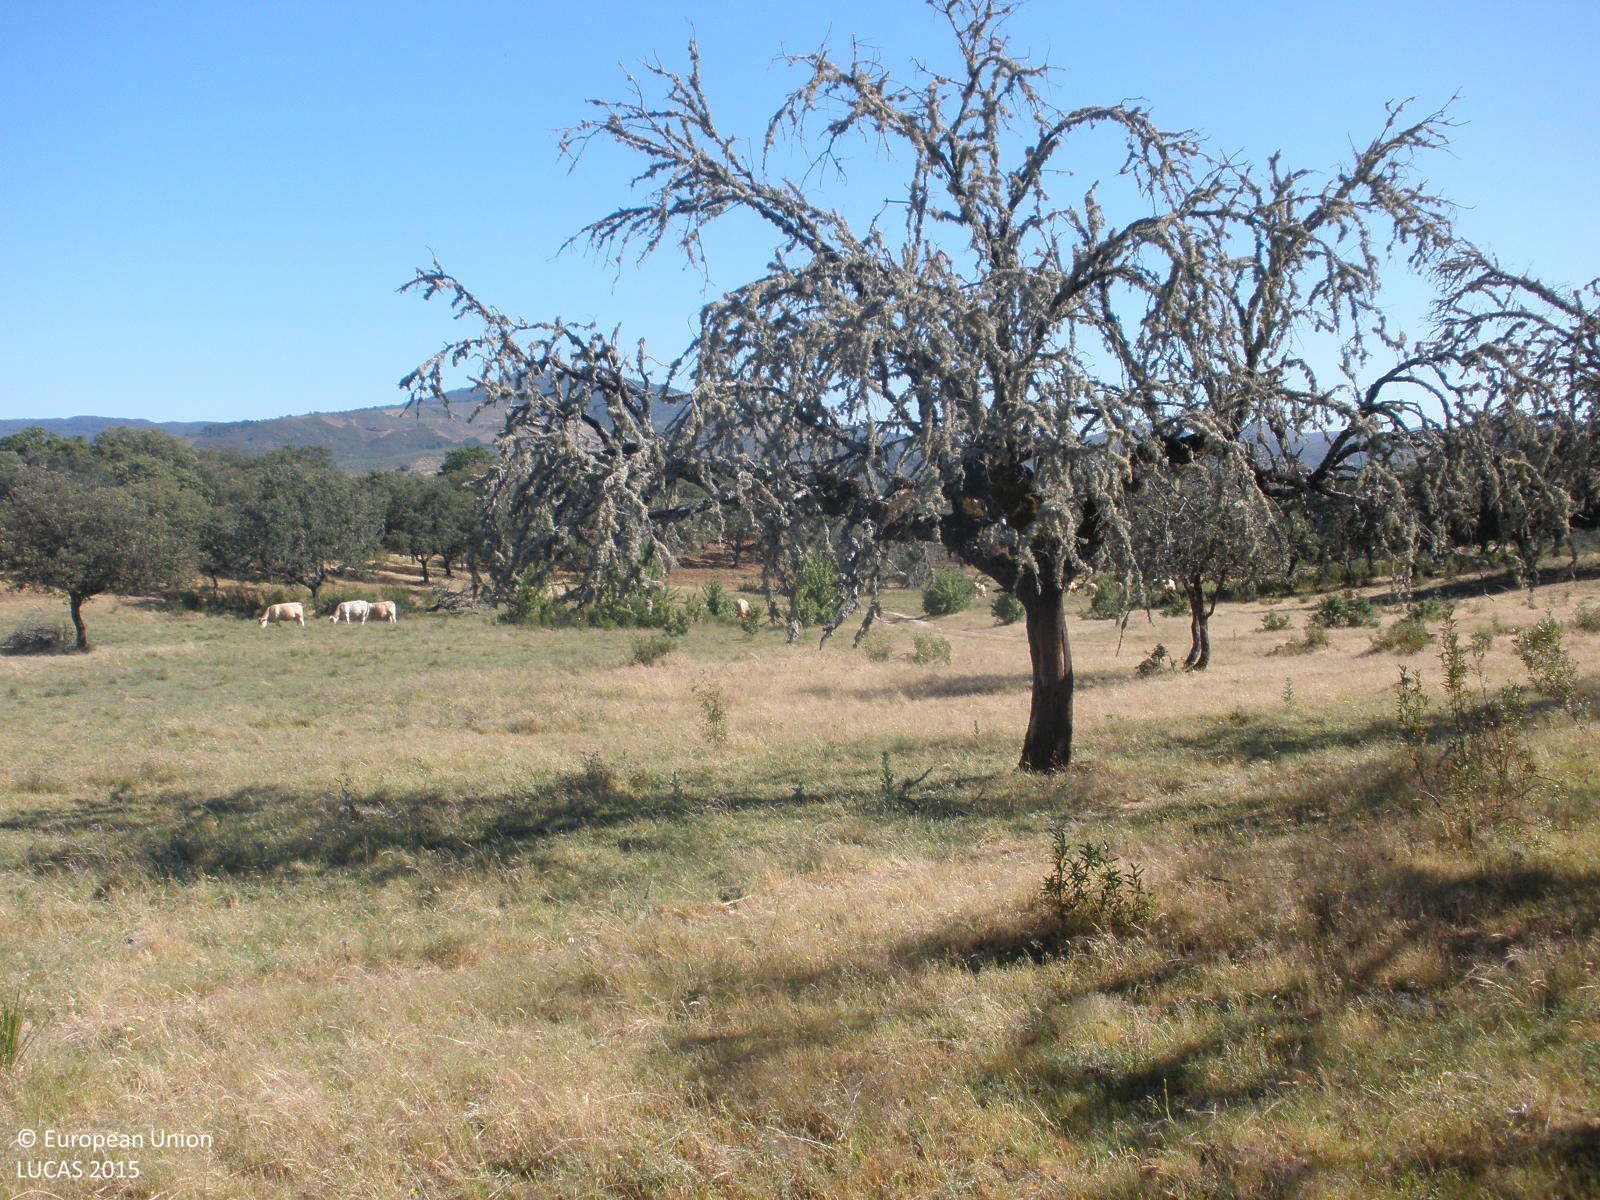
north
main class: Woodland
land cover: Broadleaved woodland
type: broadleaved evergreen forest
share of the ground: 50 - 75 %
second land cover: Grassland without tree/shrub cover
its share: > 75 %
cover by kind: herbaceous plants 60 %, broadleaved forest trees 35 %, shrubs 5 %
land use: Forestry
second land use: Agriculture (excluding fallow land and kitchen gardens)
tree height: < 5 m
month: May
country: ES
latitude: 40.2260
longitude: -6.2607
